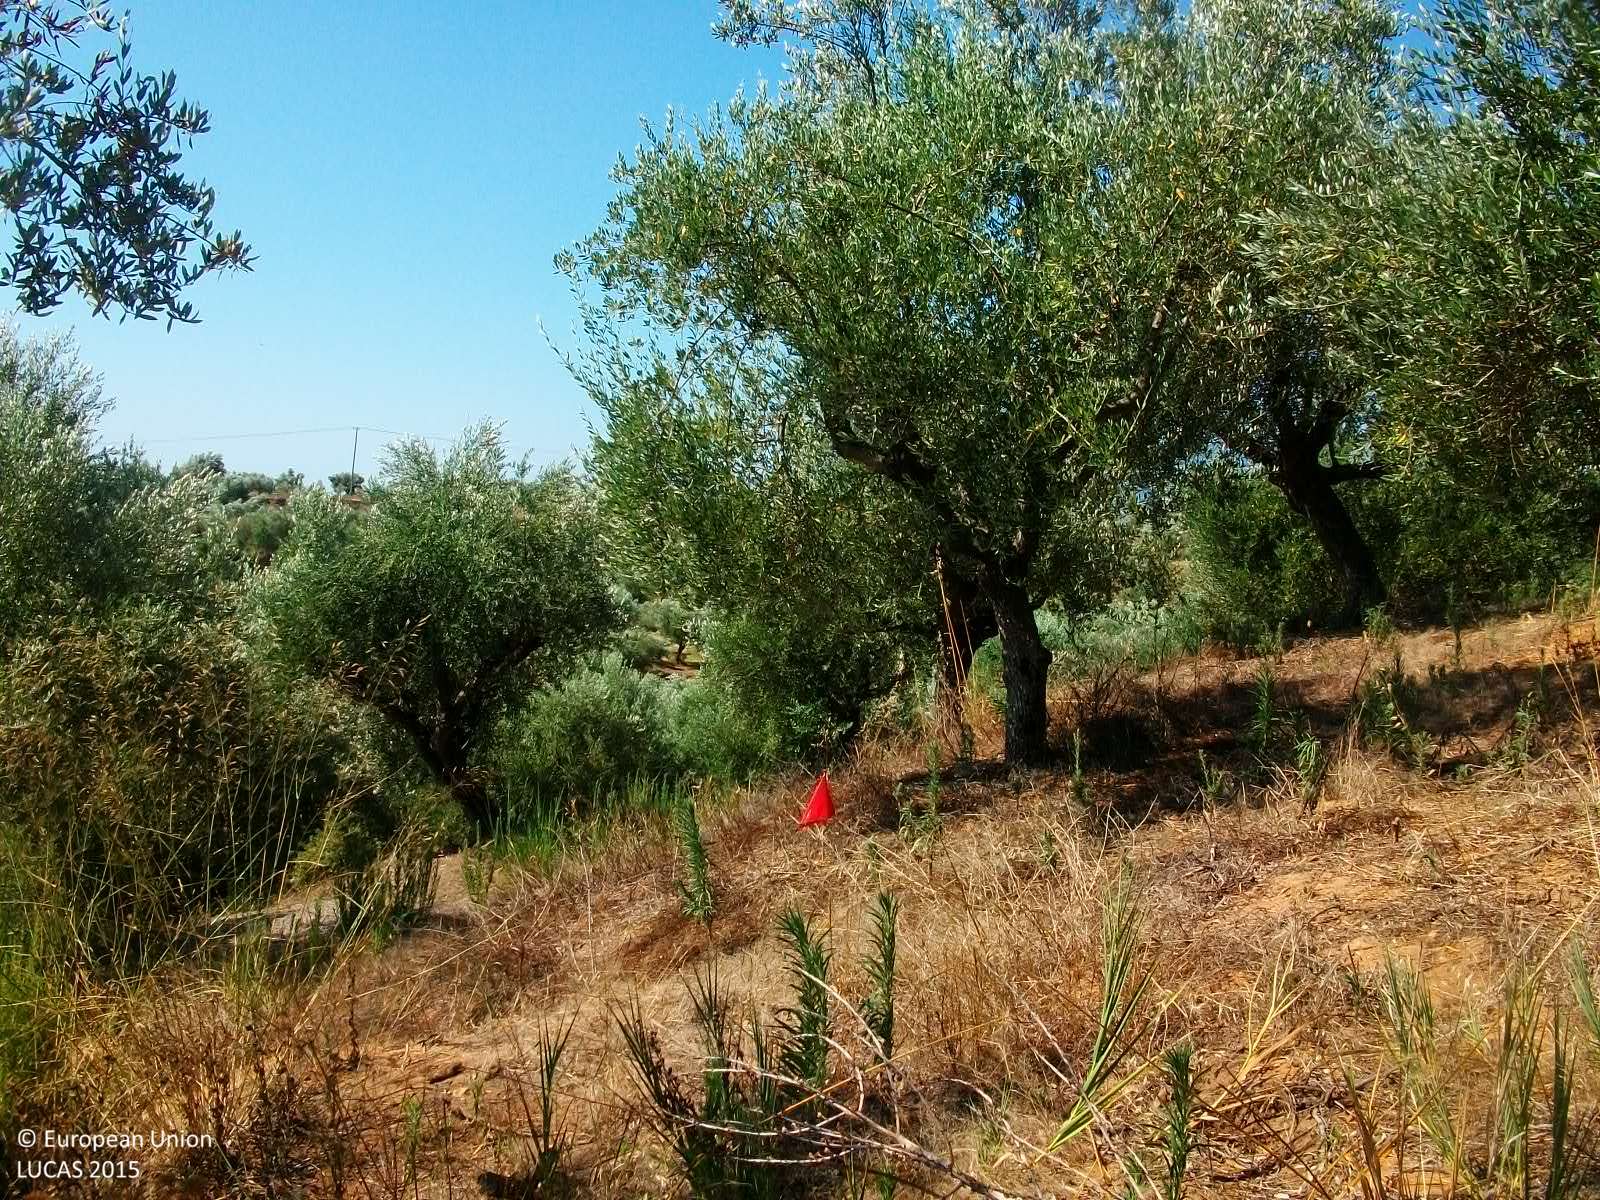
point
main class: Cropland
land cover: Olive groves
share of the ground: 25 - 50 %
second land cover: Spontaneously vegetated surfaces
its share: > 75 %
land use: Agriculture (excluding fallow land and kitchen gardens)
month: July
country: GR
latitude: 37.0102
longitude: 21.9438
